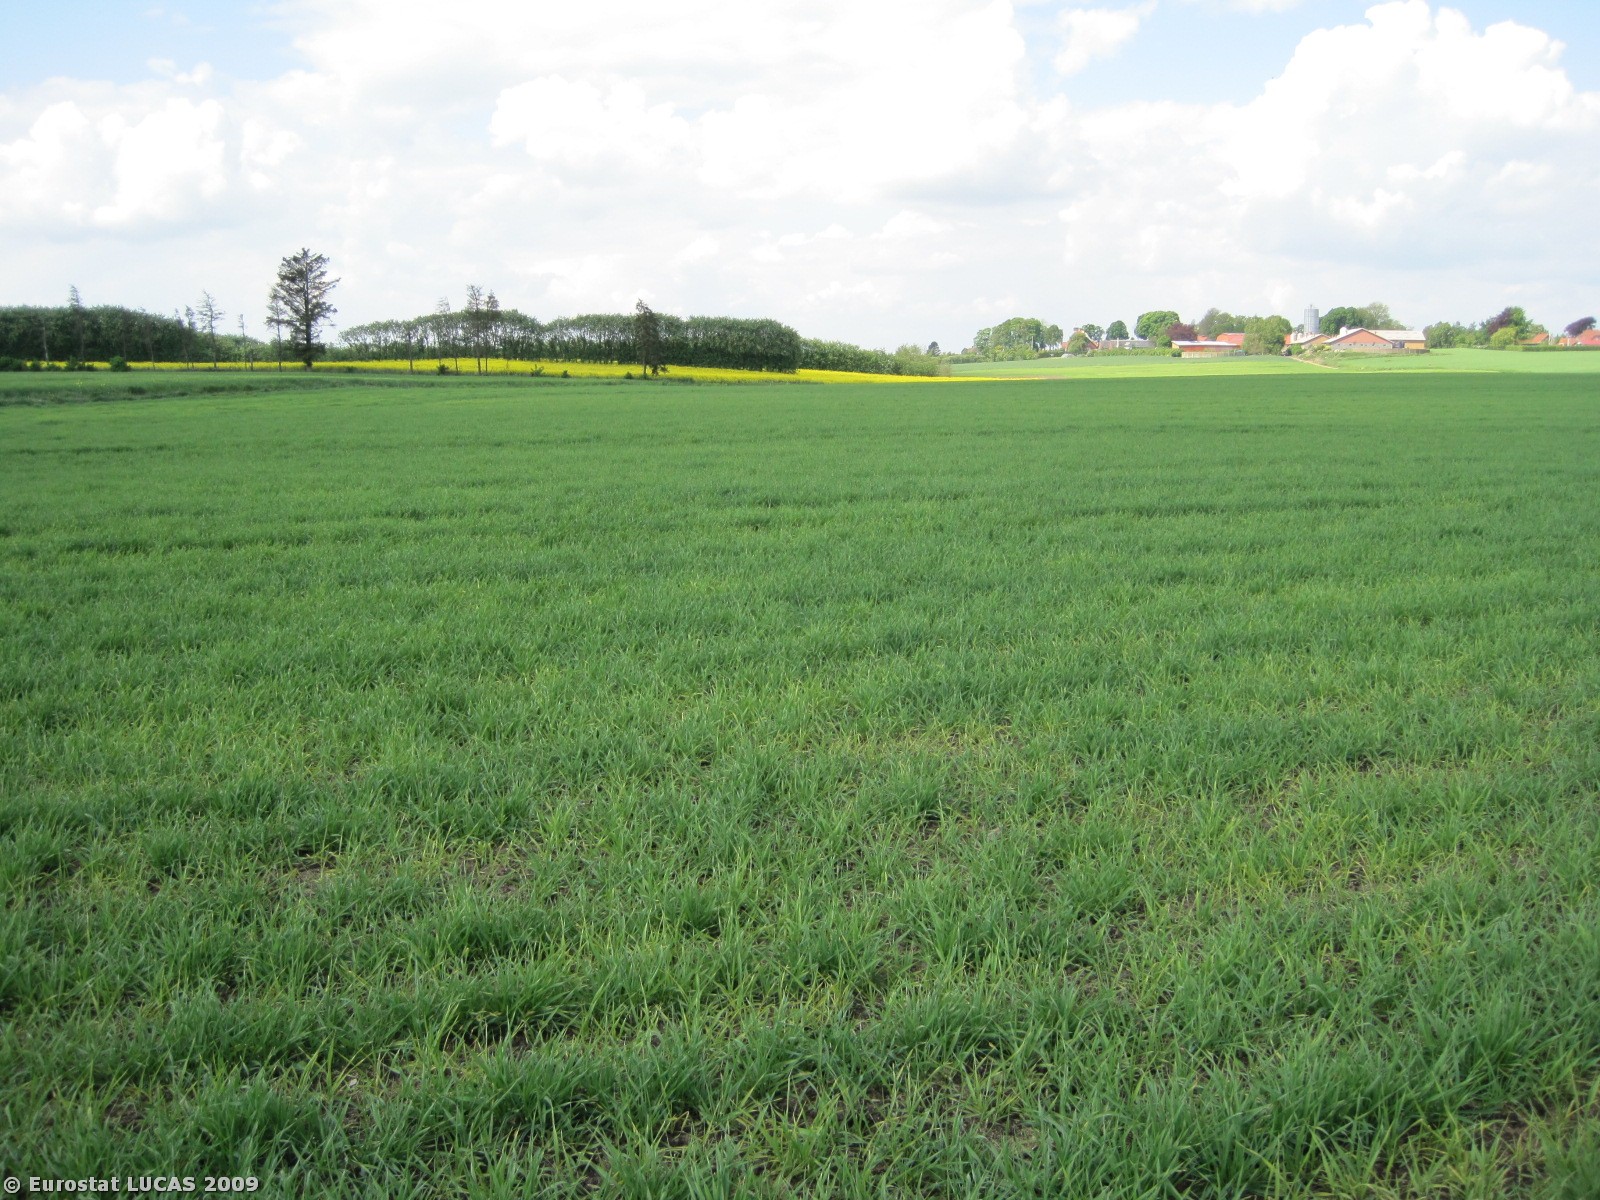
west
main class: Cropland
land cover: Barley
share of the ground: > 75 %
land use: Agriculture (excluding fallow land and kitchen gardens)
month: May
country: DK
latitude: 56.3492
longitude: 9.6929
